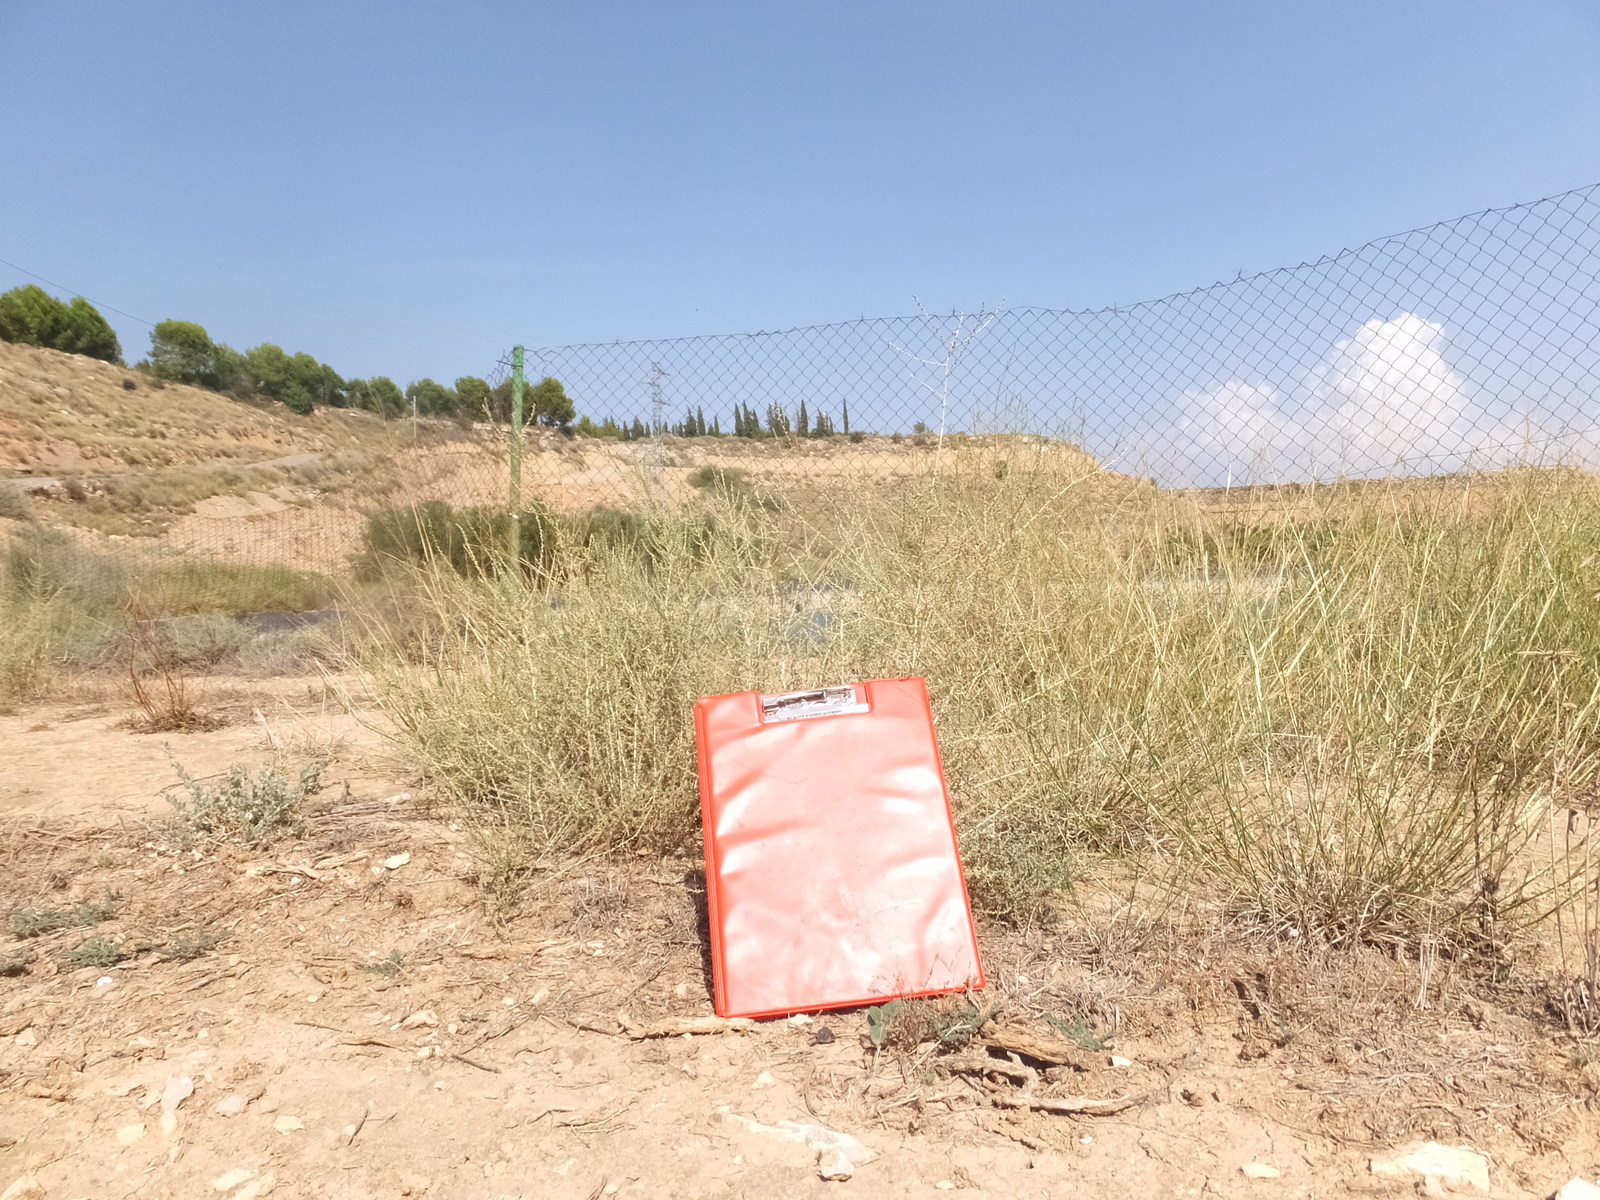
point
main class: Grassland
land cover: Grassland without tree/shrub cover
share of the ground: > 75 %
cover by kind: herbaceous plants 55 %, unconsolidated bare surface 40 %, shrubs 5 %
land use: Semi-natural and natural areas not in use
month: August
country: ES
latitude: 41.5389
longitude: 0.3618
